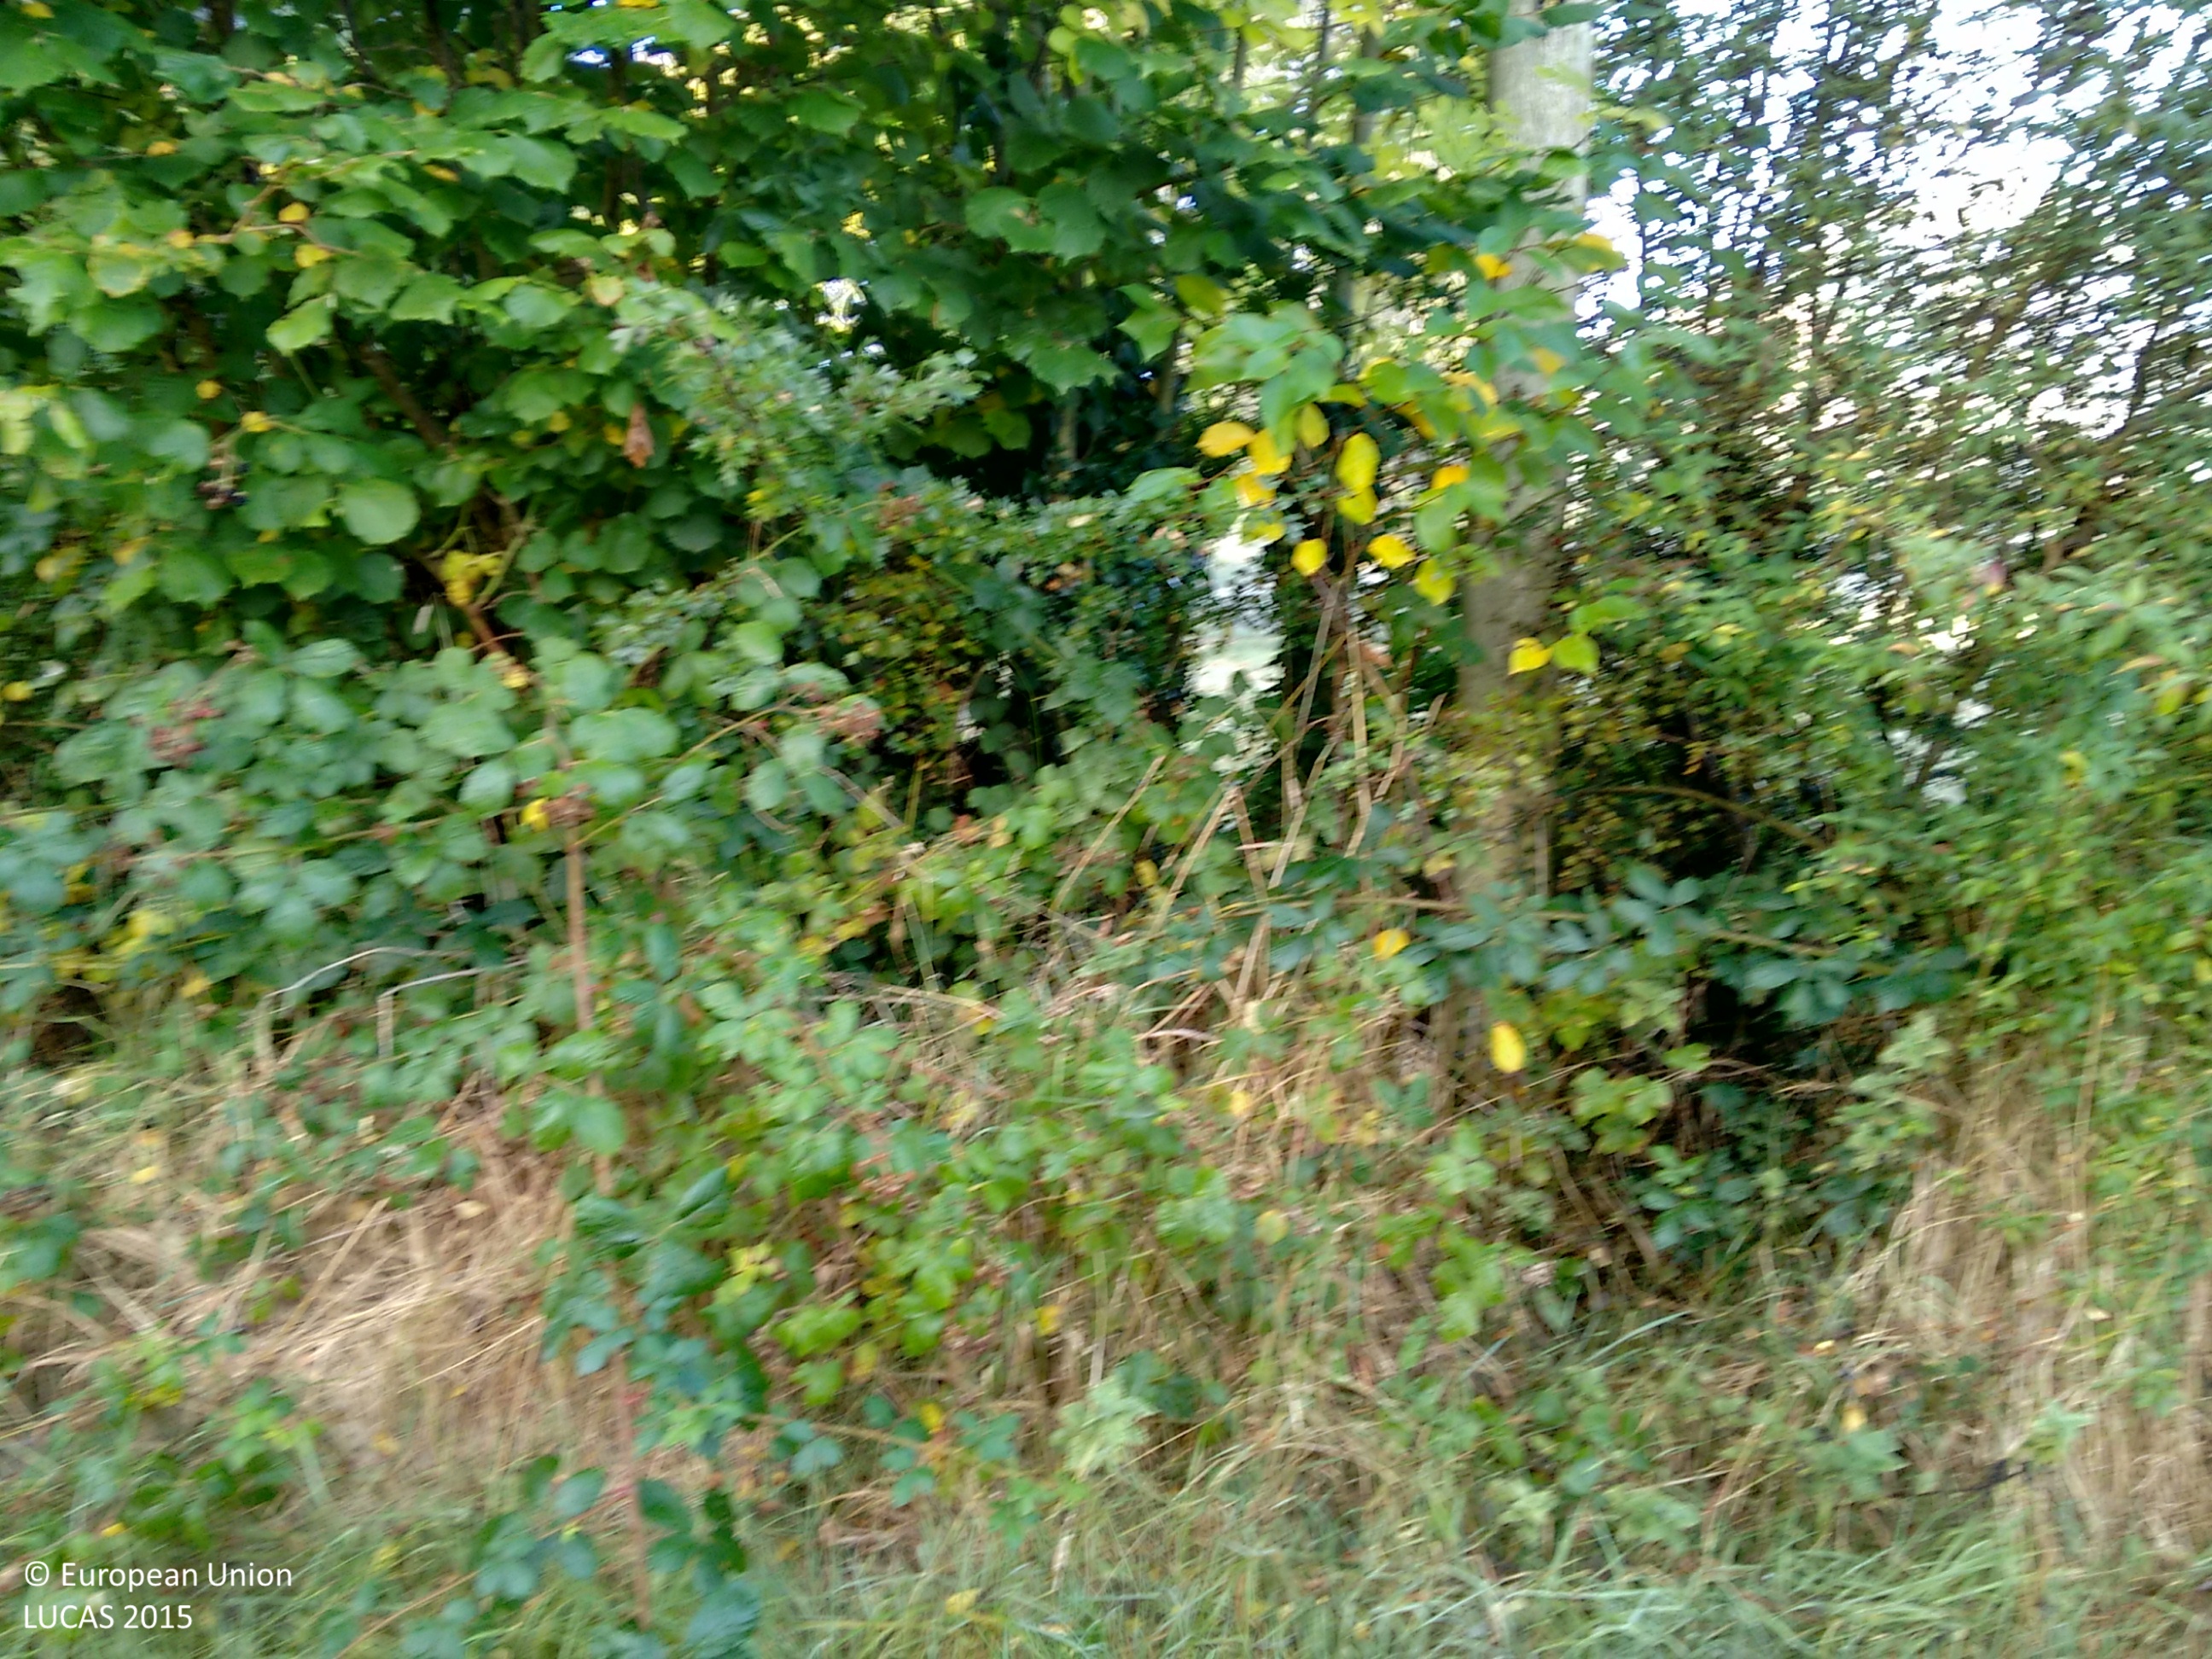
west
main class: Grassland
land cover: Grassland with sparse tree/shrub cover
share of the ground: > 75 %
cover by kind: herbaceous plants 95 %, broadleaved forest trees 5 %
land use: Agriculture (excluding fallow land and kitchen gardens)
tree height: > 5 m
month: October
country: GB
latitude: 54.4309
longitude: -7.7854
